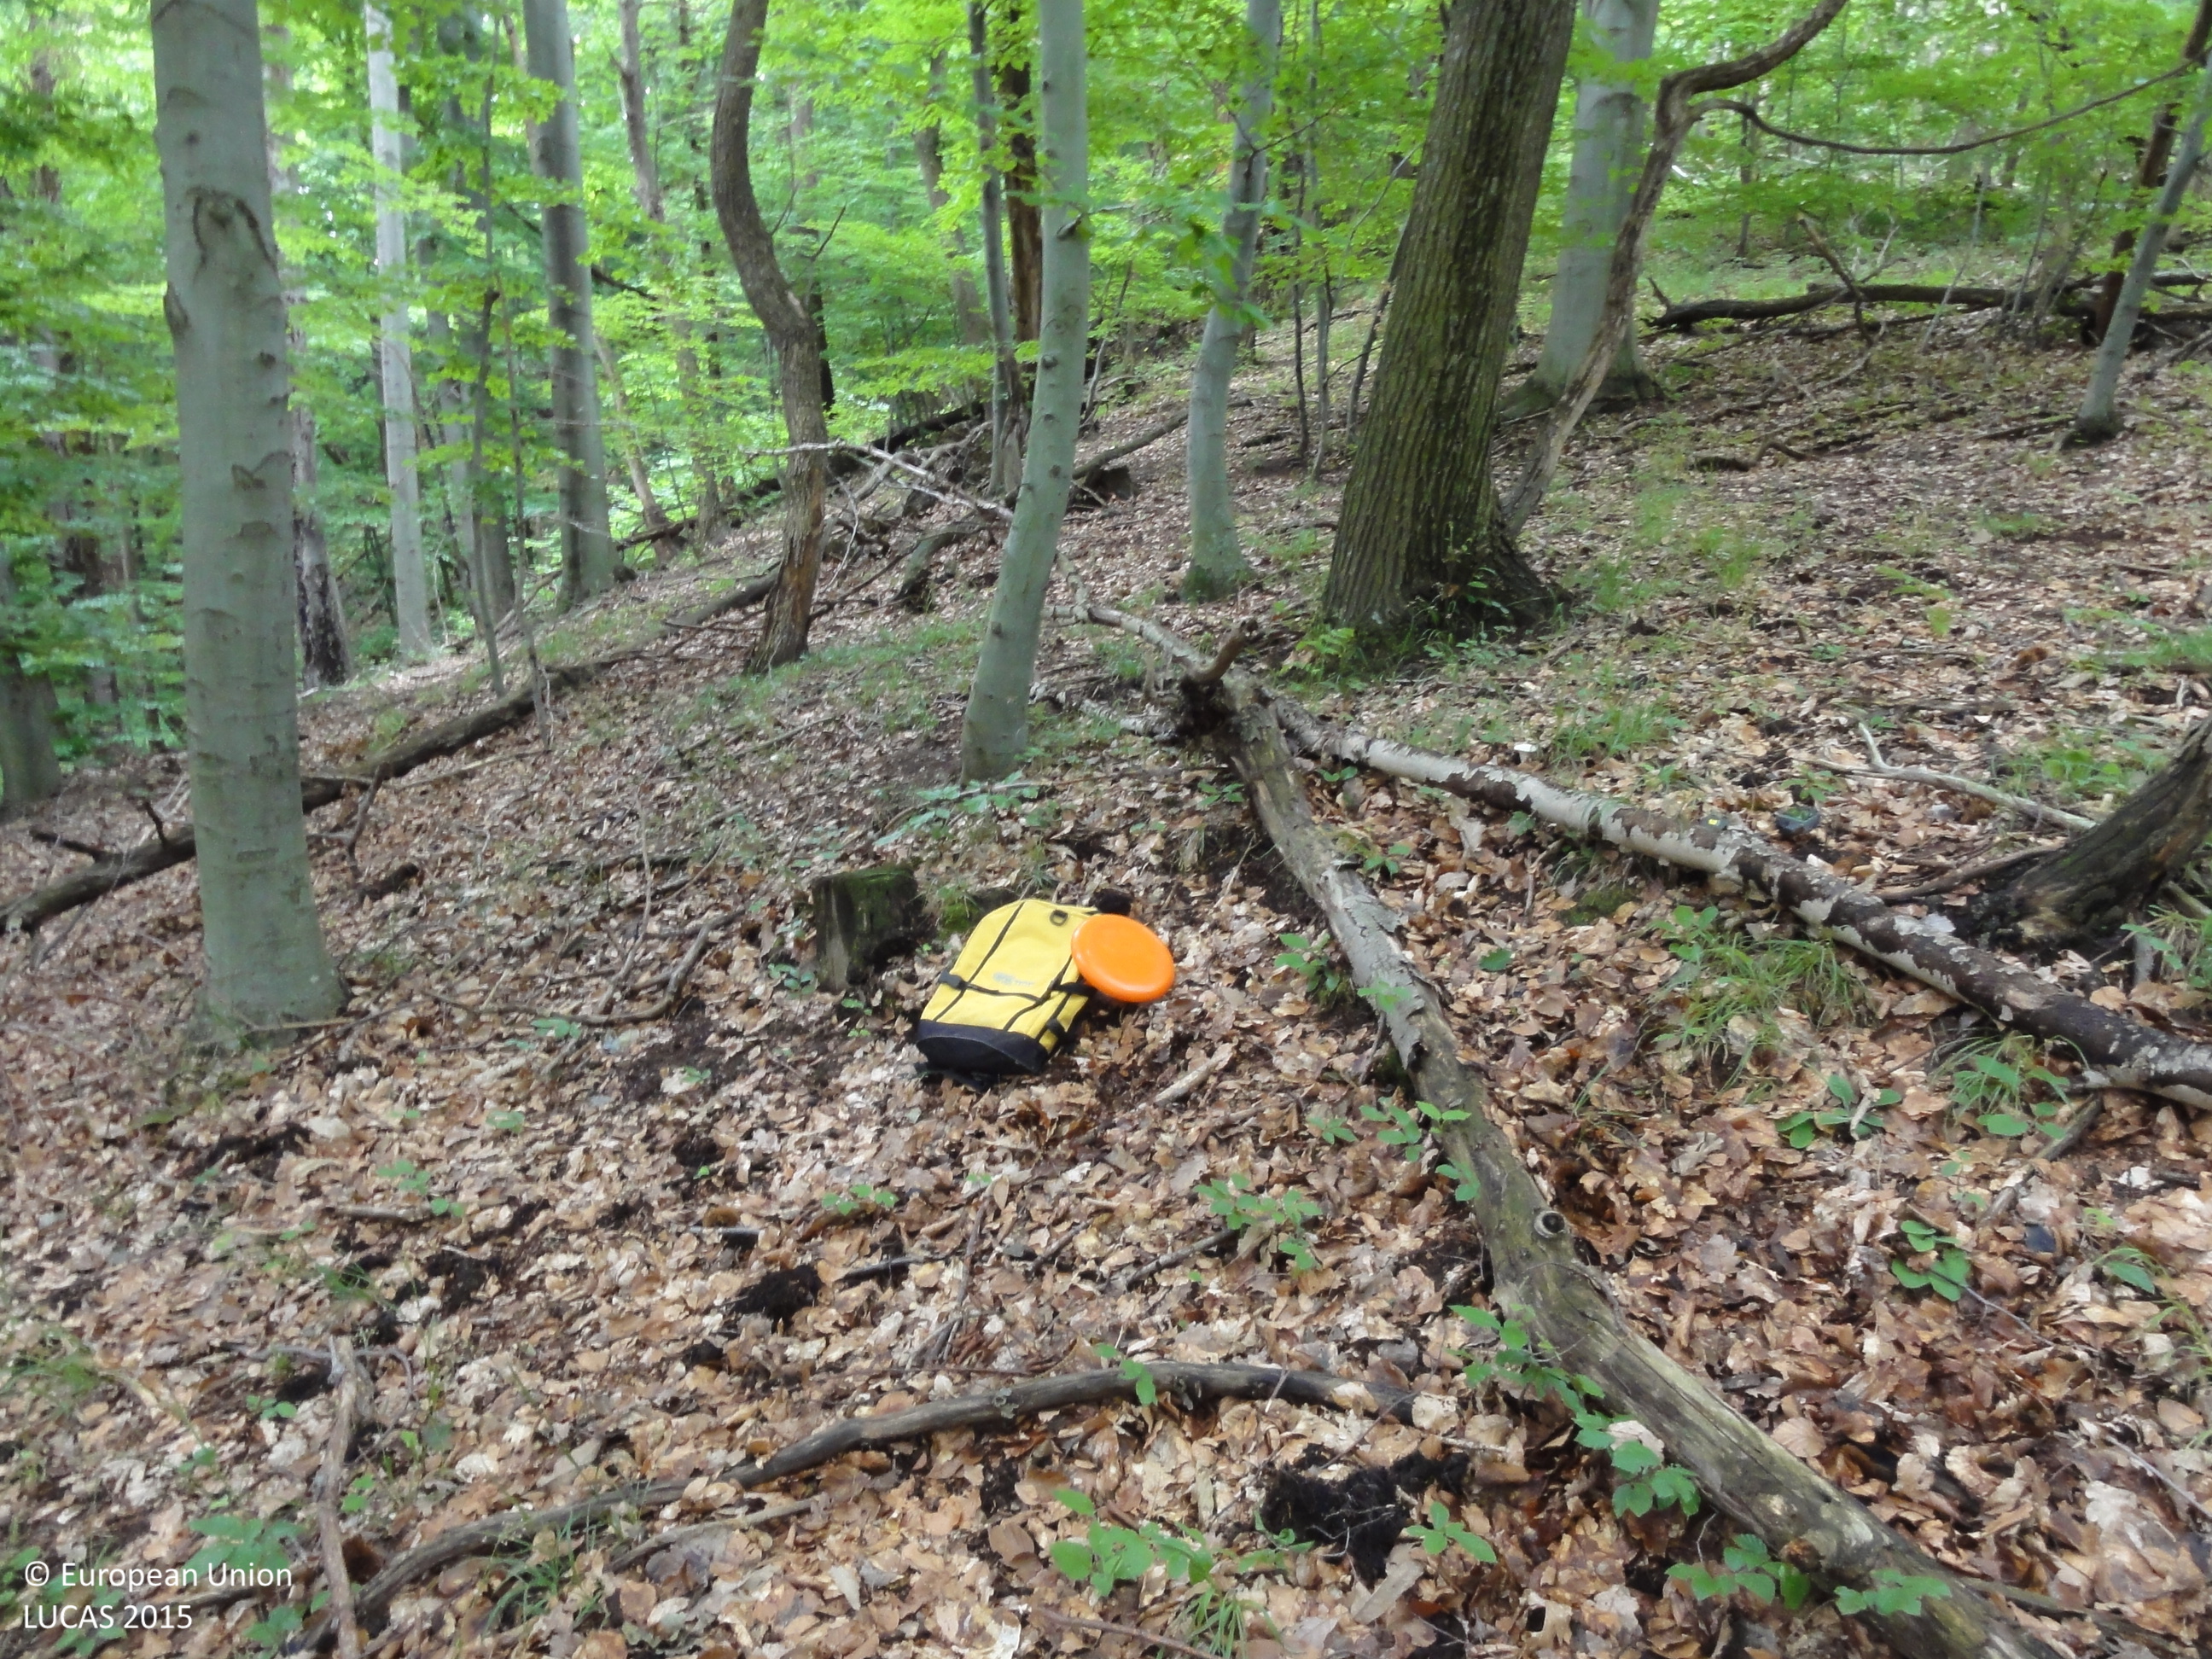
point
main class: Woodland
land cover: Broadleaved woodland
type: beech forest
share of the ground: > 75 %
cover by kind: broadleaved forest trees 100 %
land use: Forestry
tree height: > 5 m
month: June
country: SI
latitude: 46.3256
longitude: 15.7007
